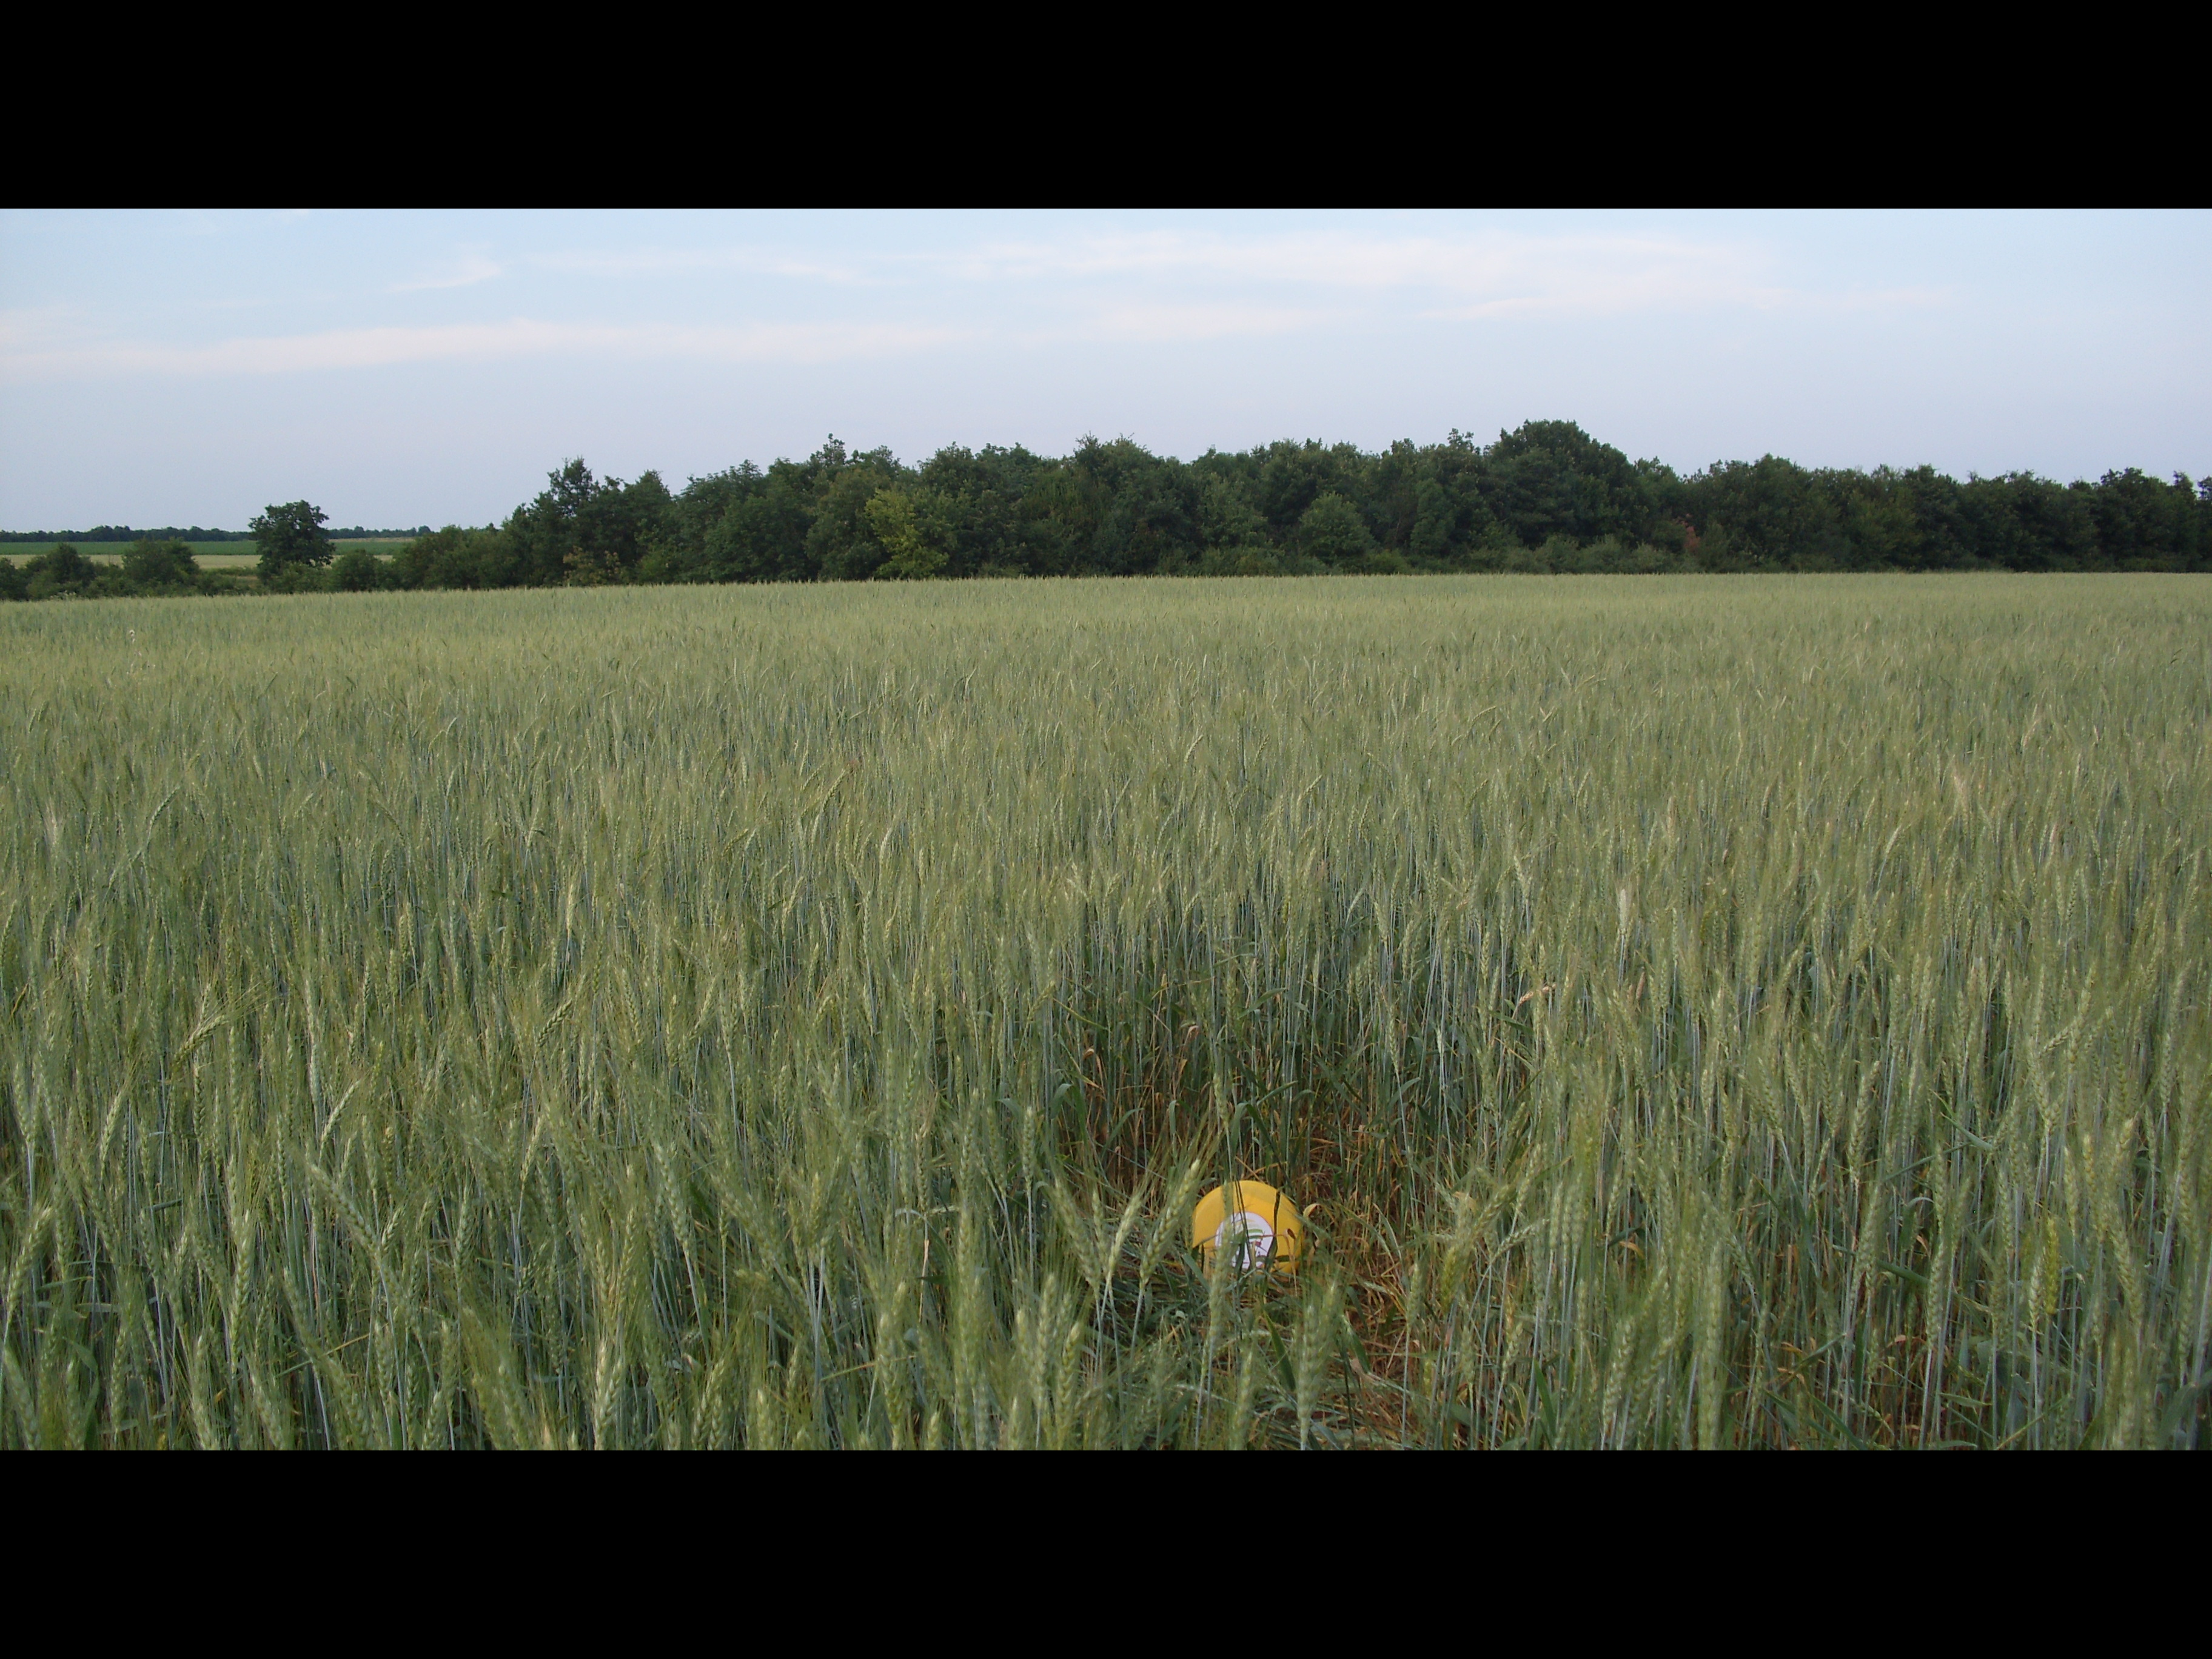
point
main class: Cropland
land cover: Common wheat
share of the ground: > 75 %
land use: Agriculture (excluding fallow land and kitchen gardens)
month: June
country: BG
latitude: 43.5066
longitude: 23.3136
